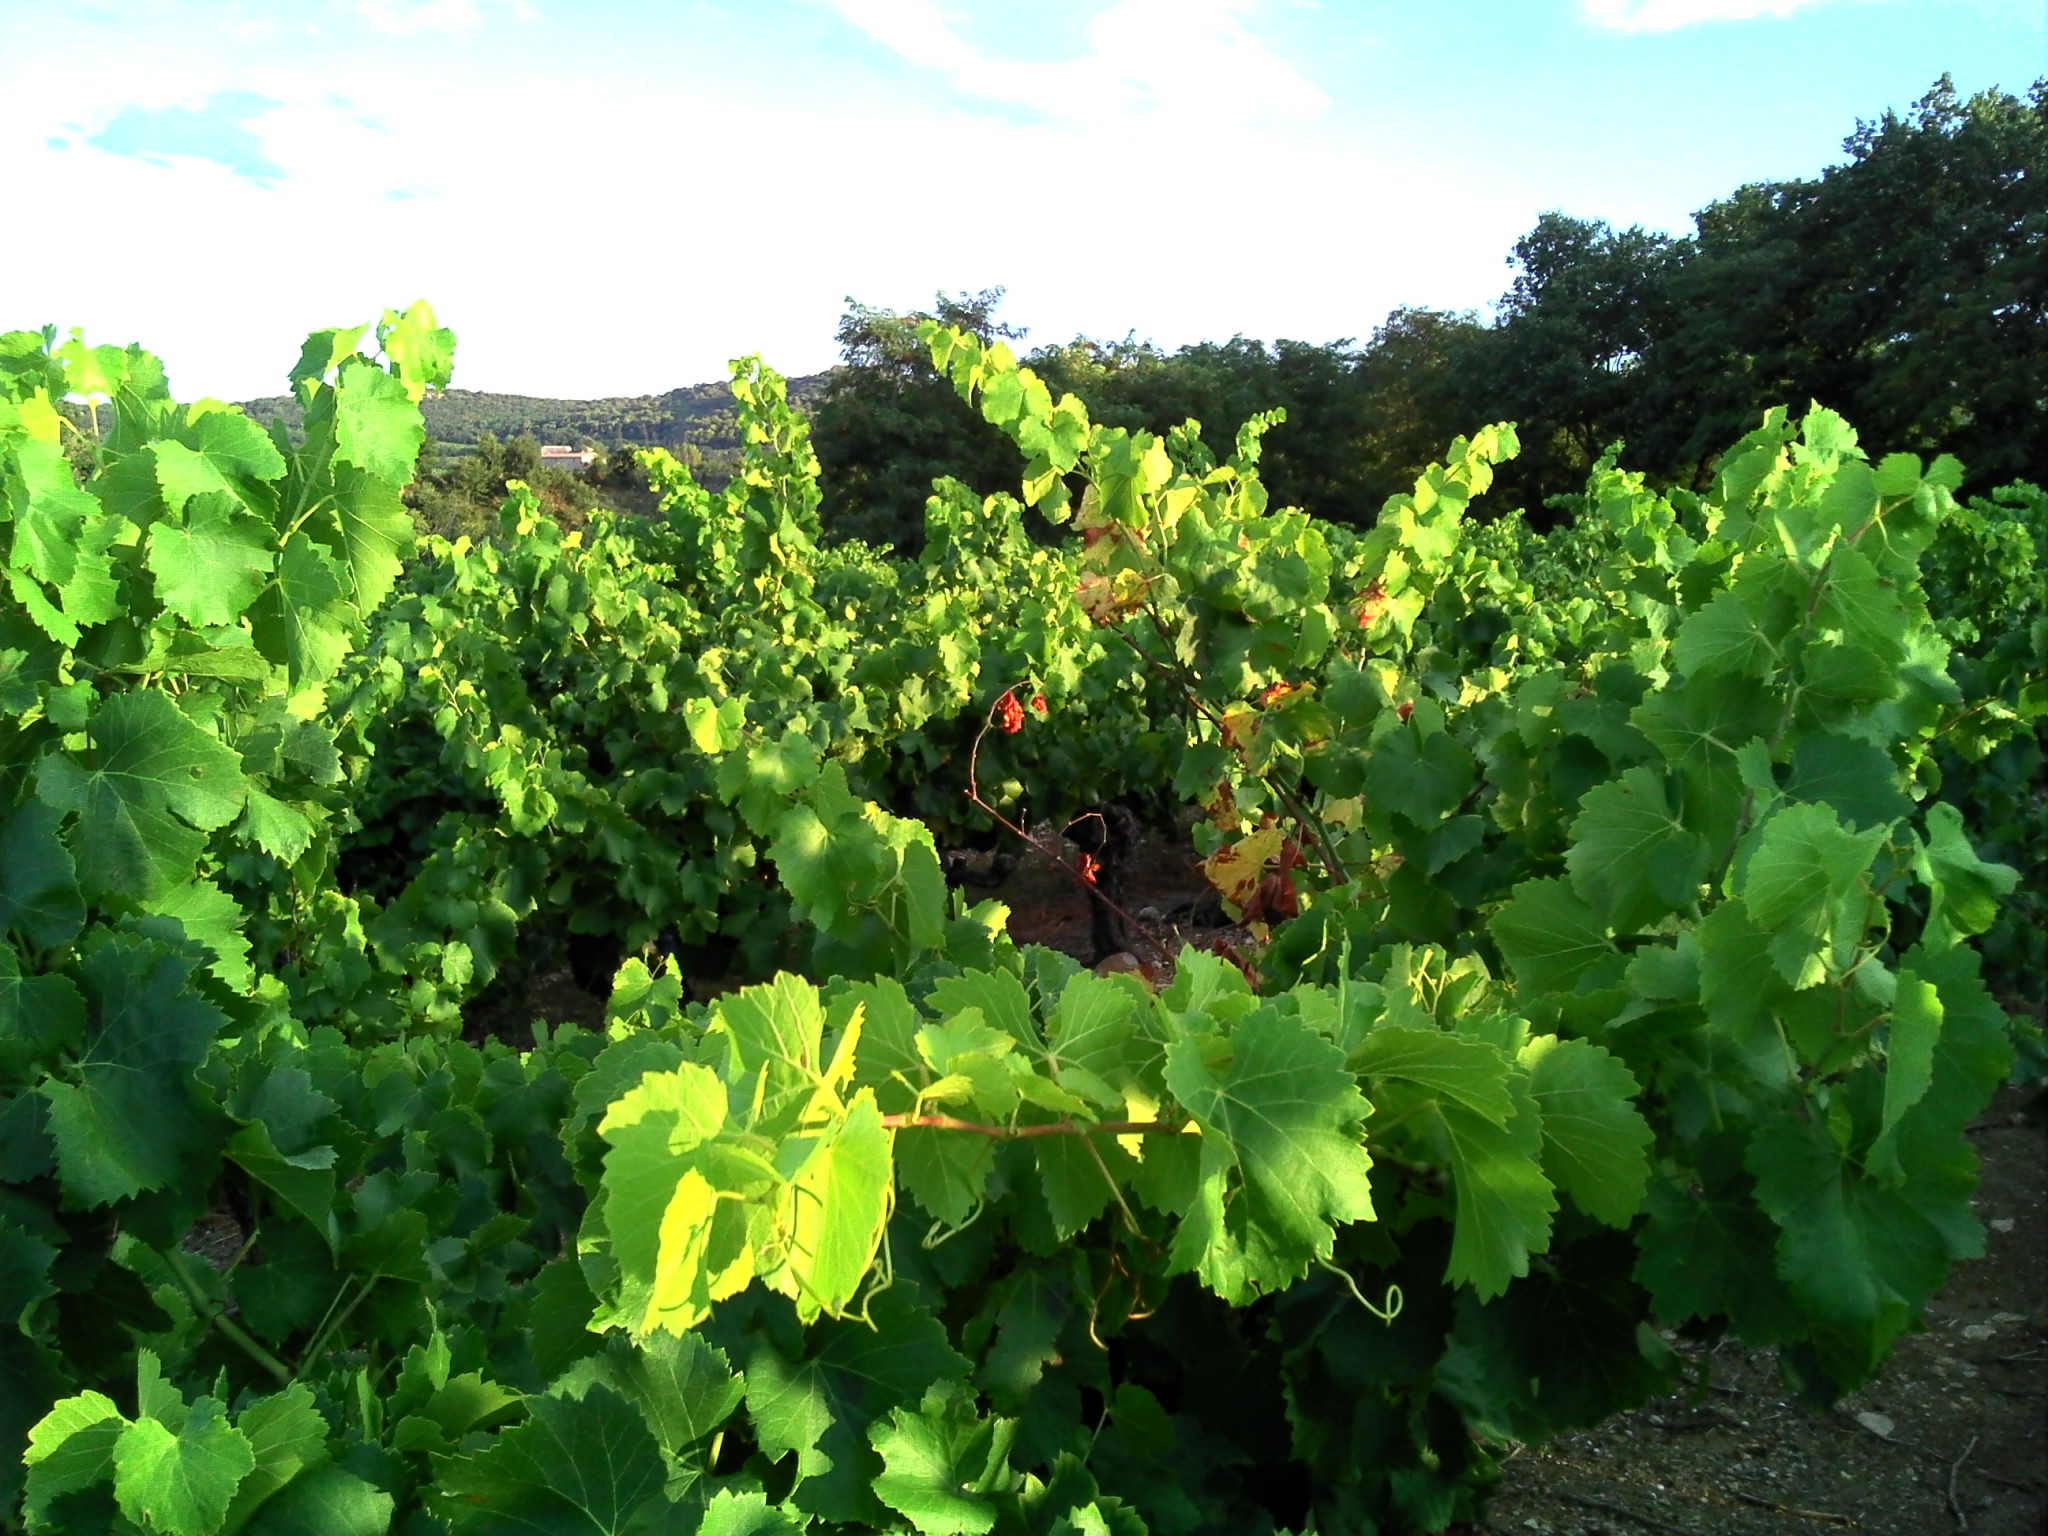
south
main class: Cropland
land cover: Vineyards
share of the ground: 50 - 75 %
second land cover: Spontaneously vegetated surfaces
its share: 25 - 50 %
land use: Agriculture (excluding fallow land and kitchen gardens)
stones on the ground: < 10 %
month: August
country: FR
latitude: 44.2300
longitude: 4.6368
